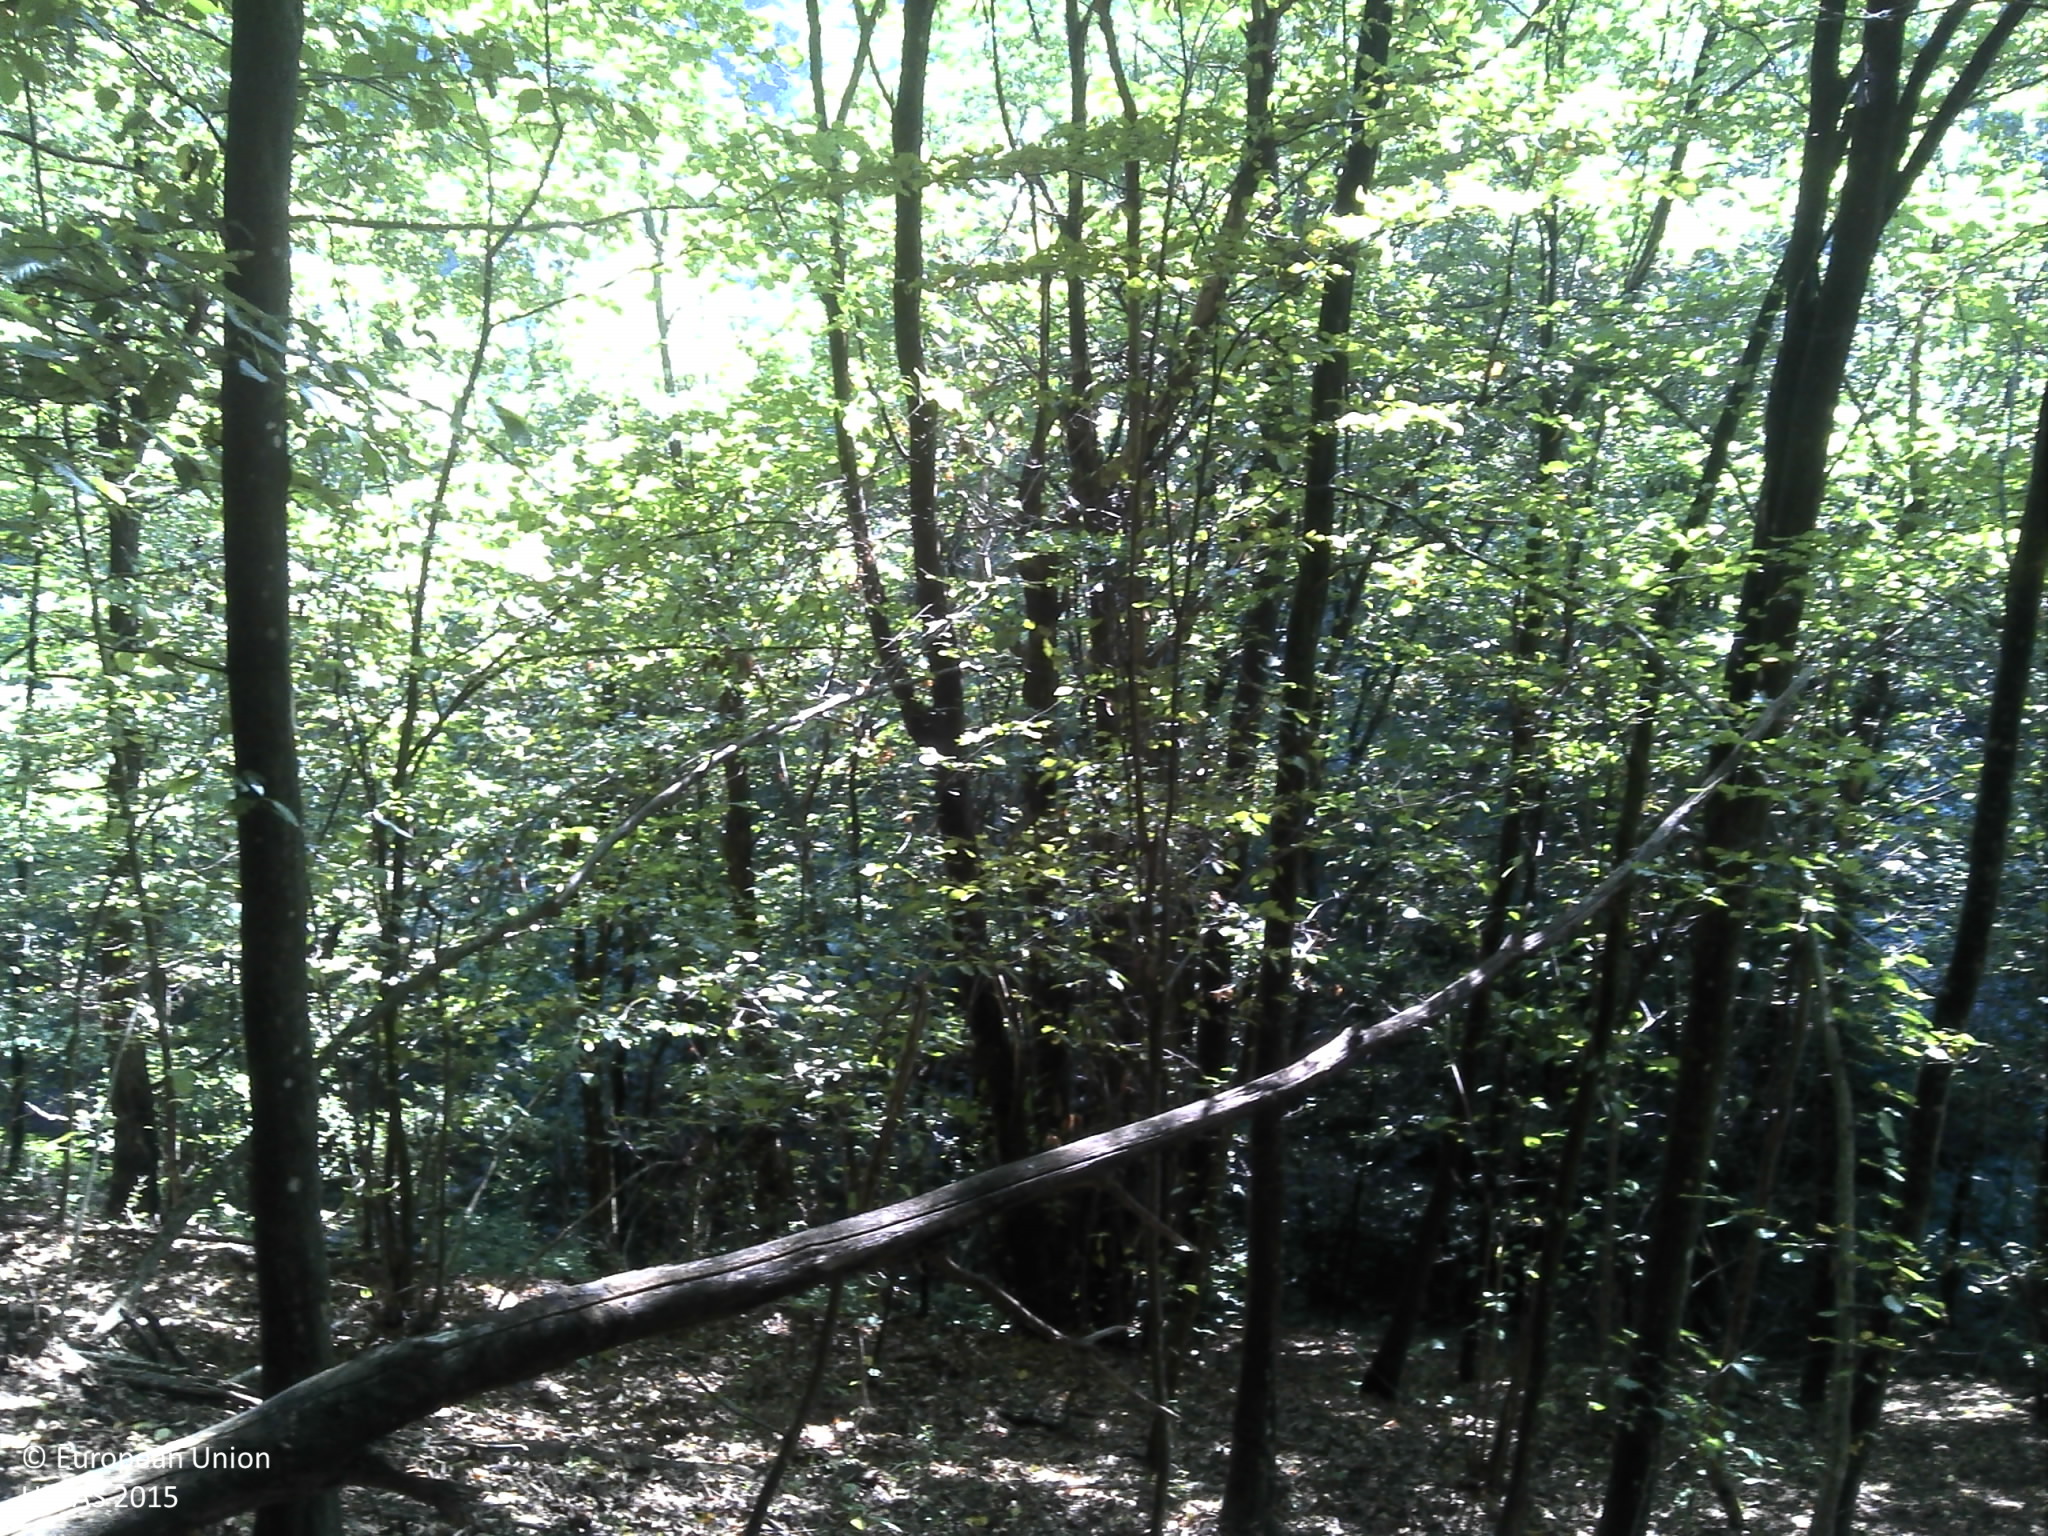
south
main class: Woodland
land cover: Broadleaved woodland
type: beech forest
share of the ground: > 75 %
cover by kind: broadleaved forest trees 100 %
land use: Forestry
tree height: > 5 m
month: August
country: HR
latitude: 45.2407
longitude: 16.3539
